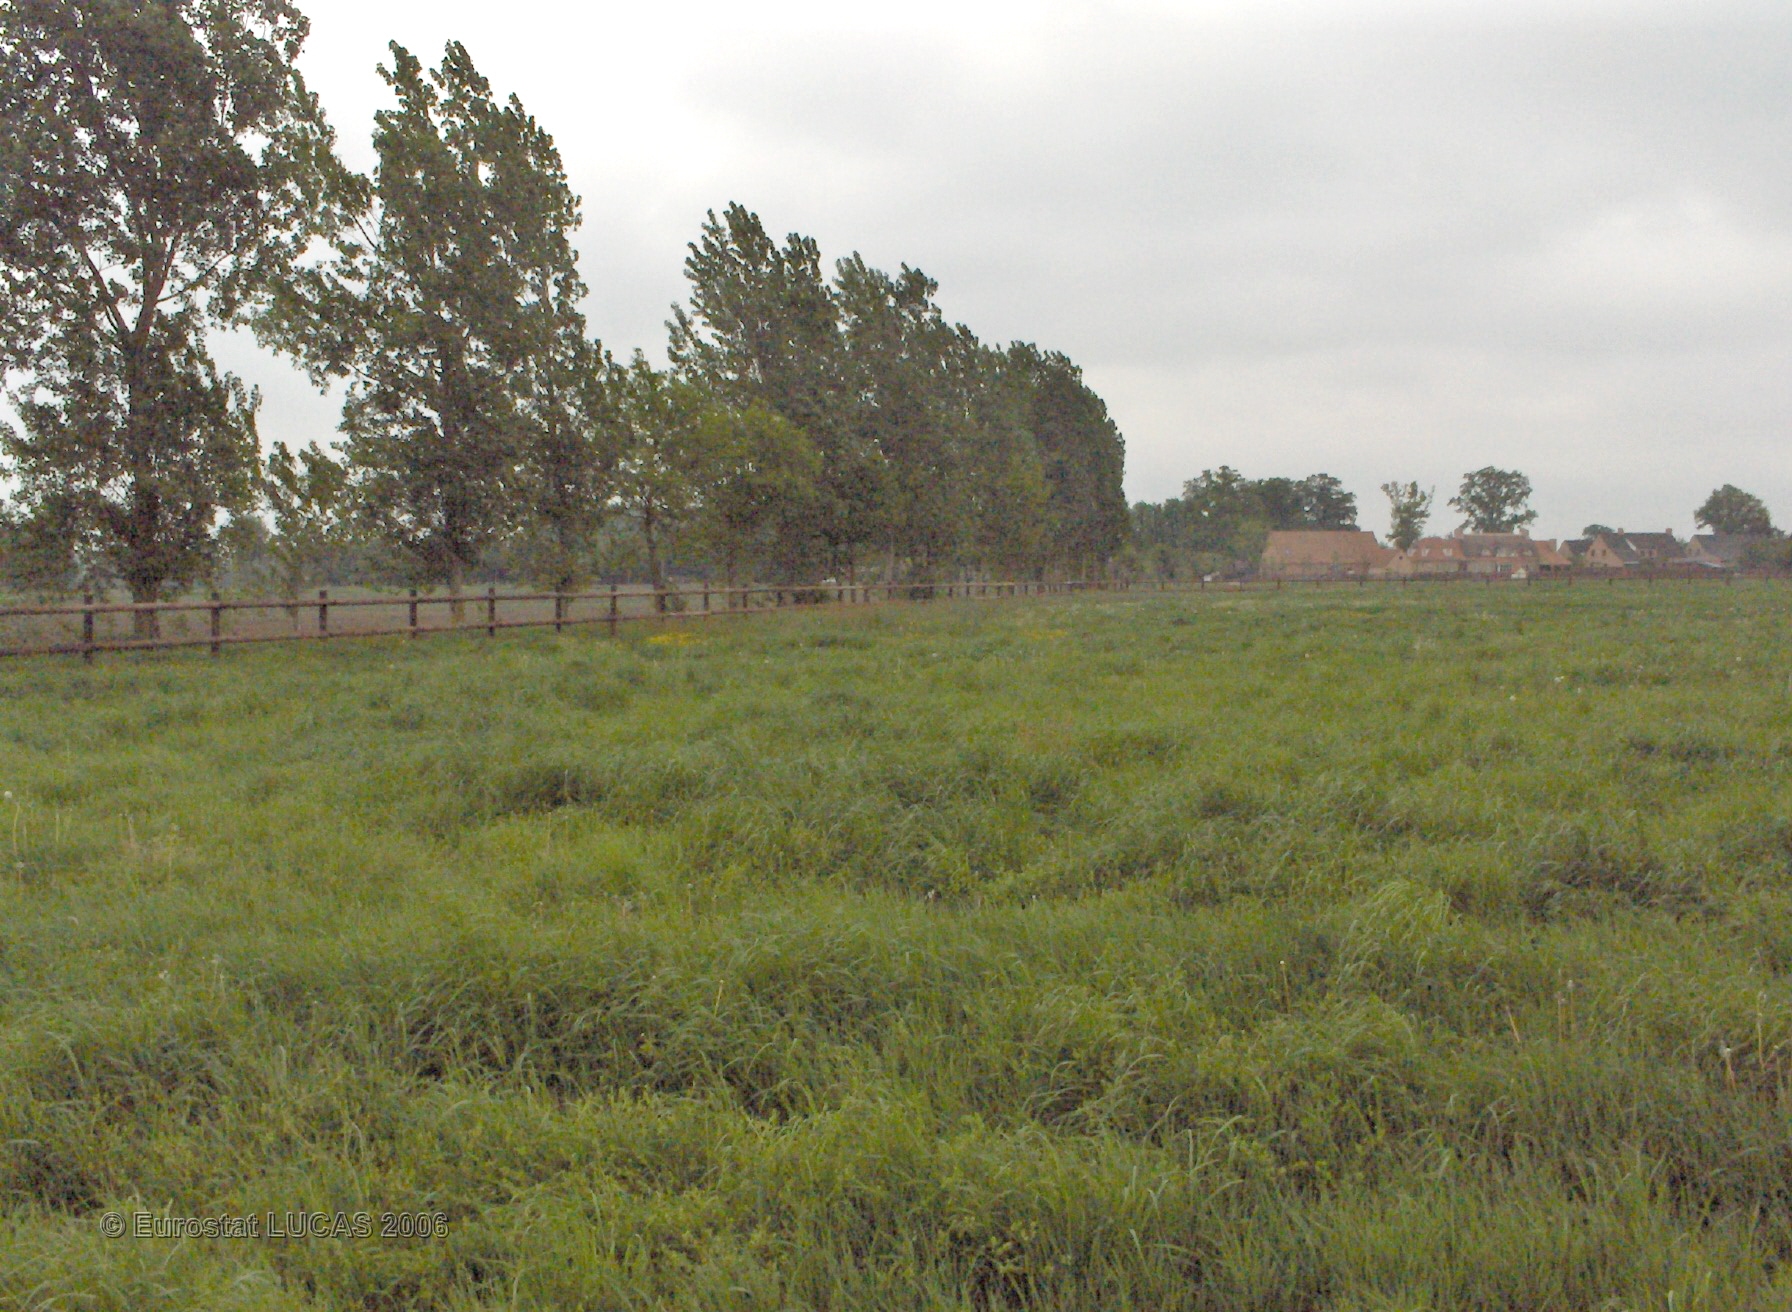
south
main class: Grassland
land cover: Grassland without tree/shrub cover
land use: Agriculture (excluding fallow land and kitchen gardens)
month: May
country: BE
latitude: 51.4537
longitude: 4.4263
